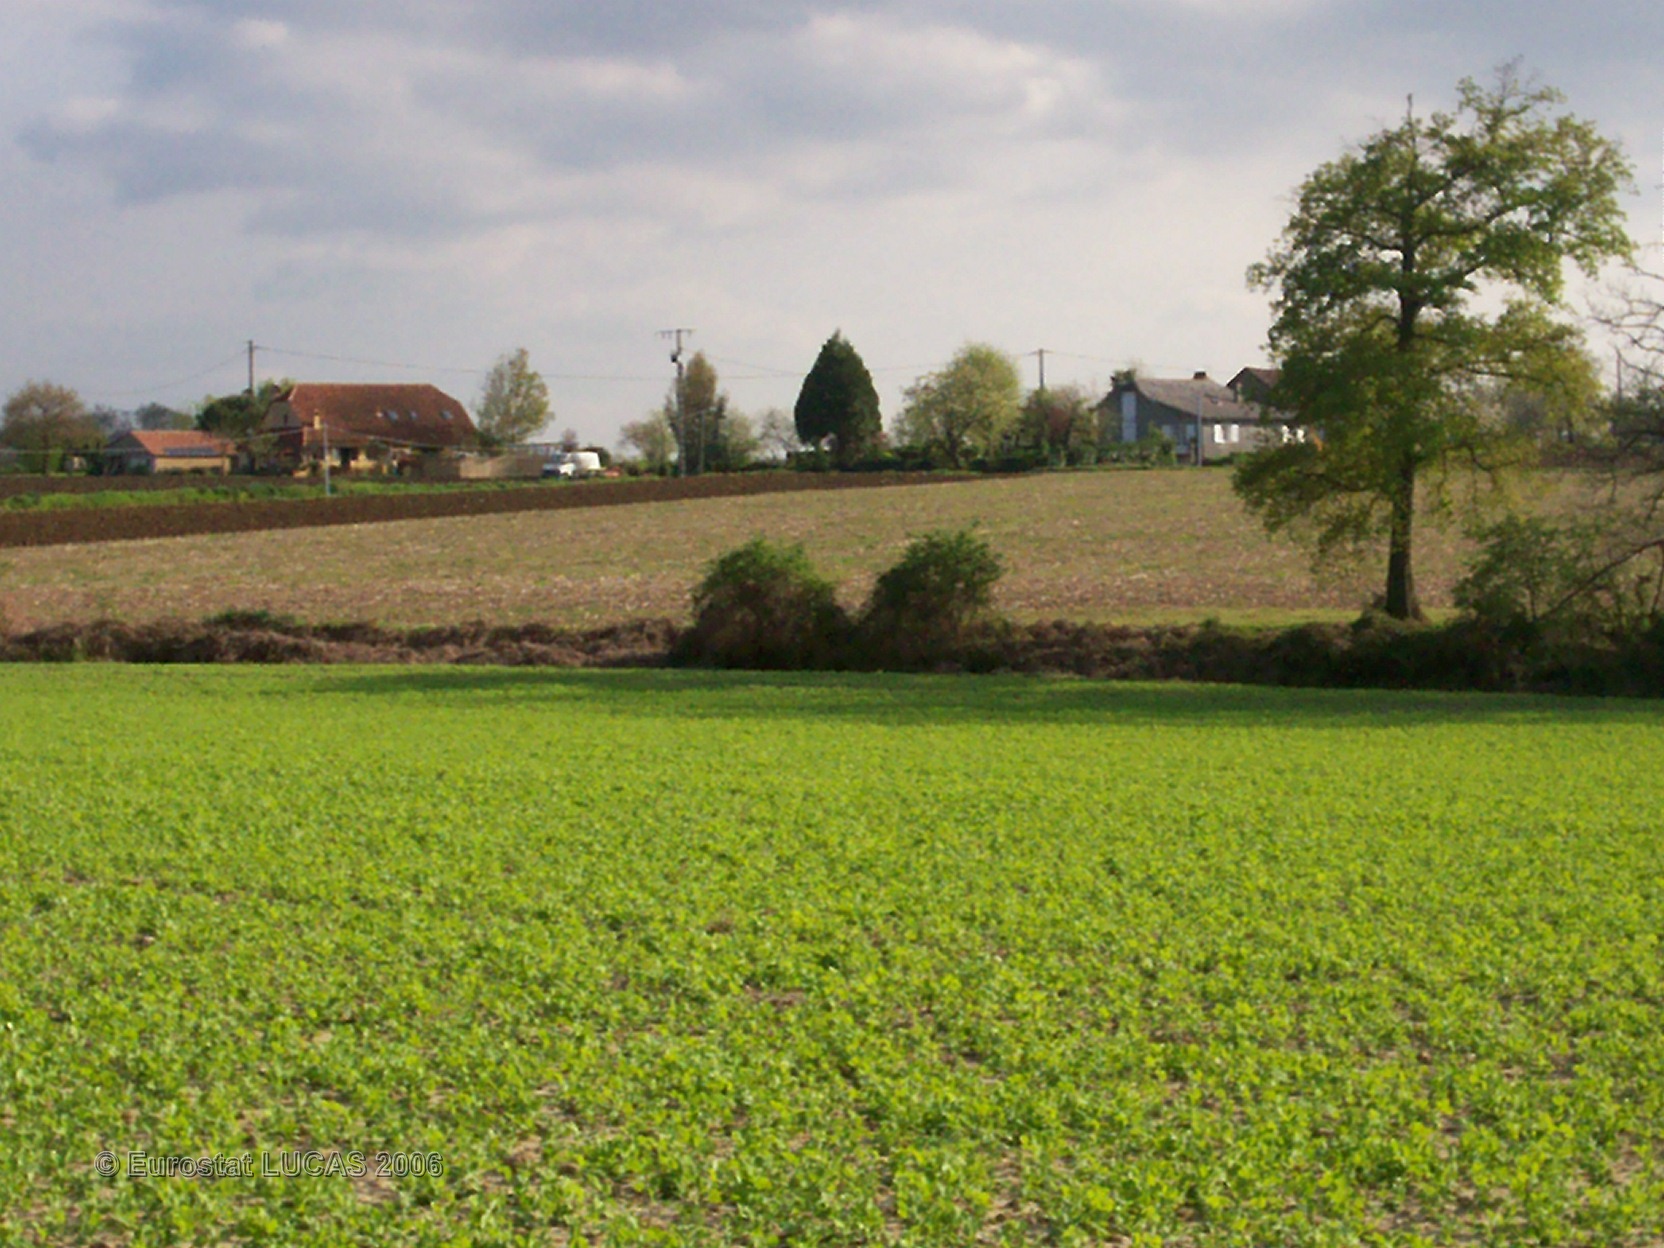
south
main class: Cropland
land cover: Dry pulses
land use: Agriculture (excluding fallow land and kitchen gardens)
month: April
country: FR
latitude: 43.4167
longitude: -0.3199
